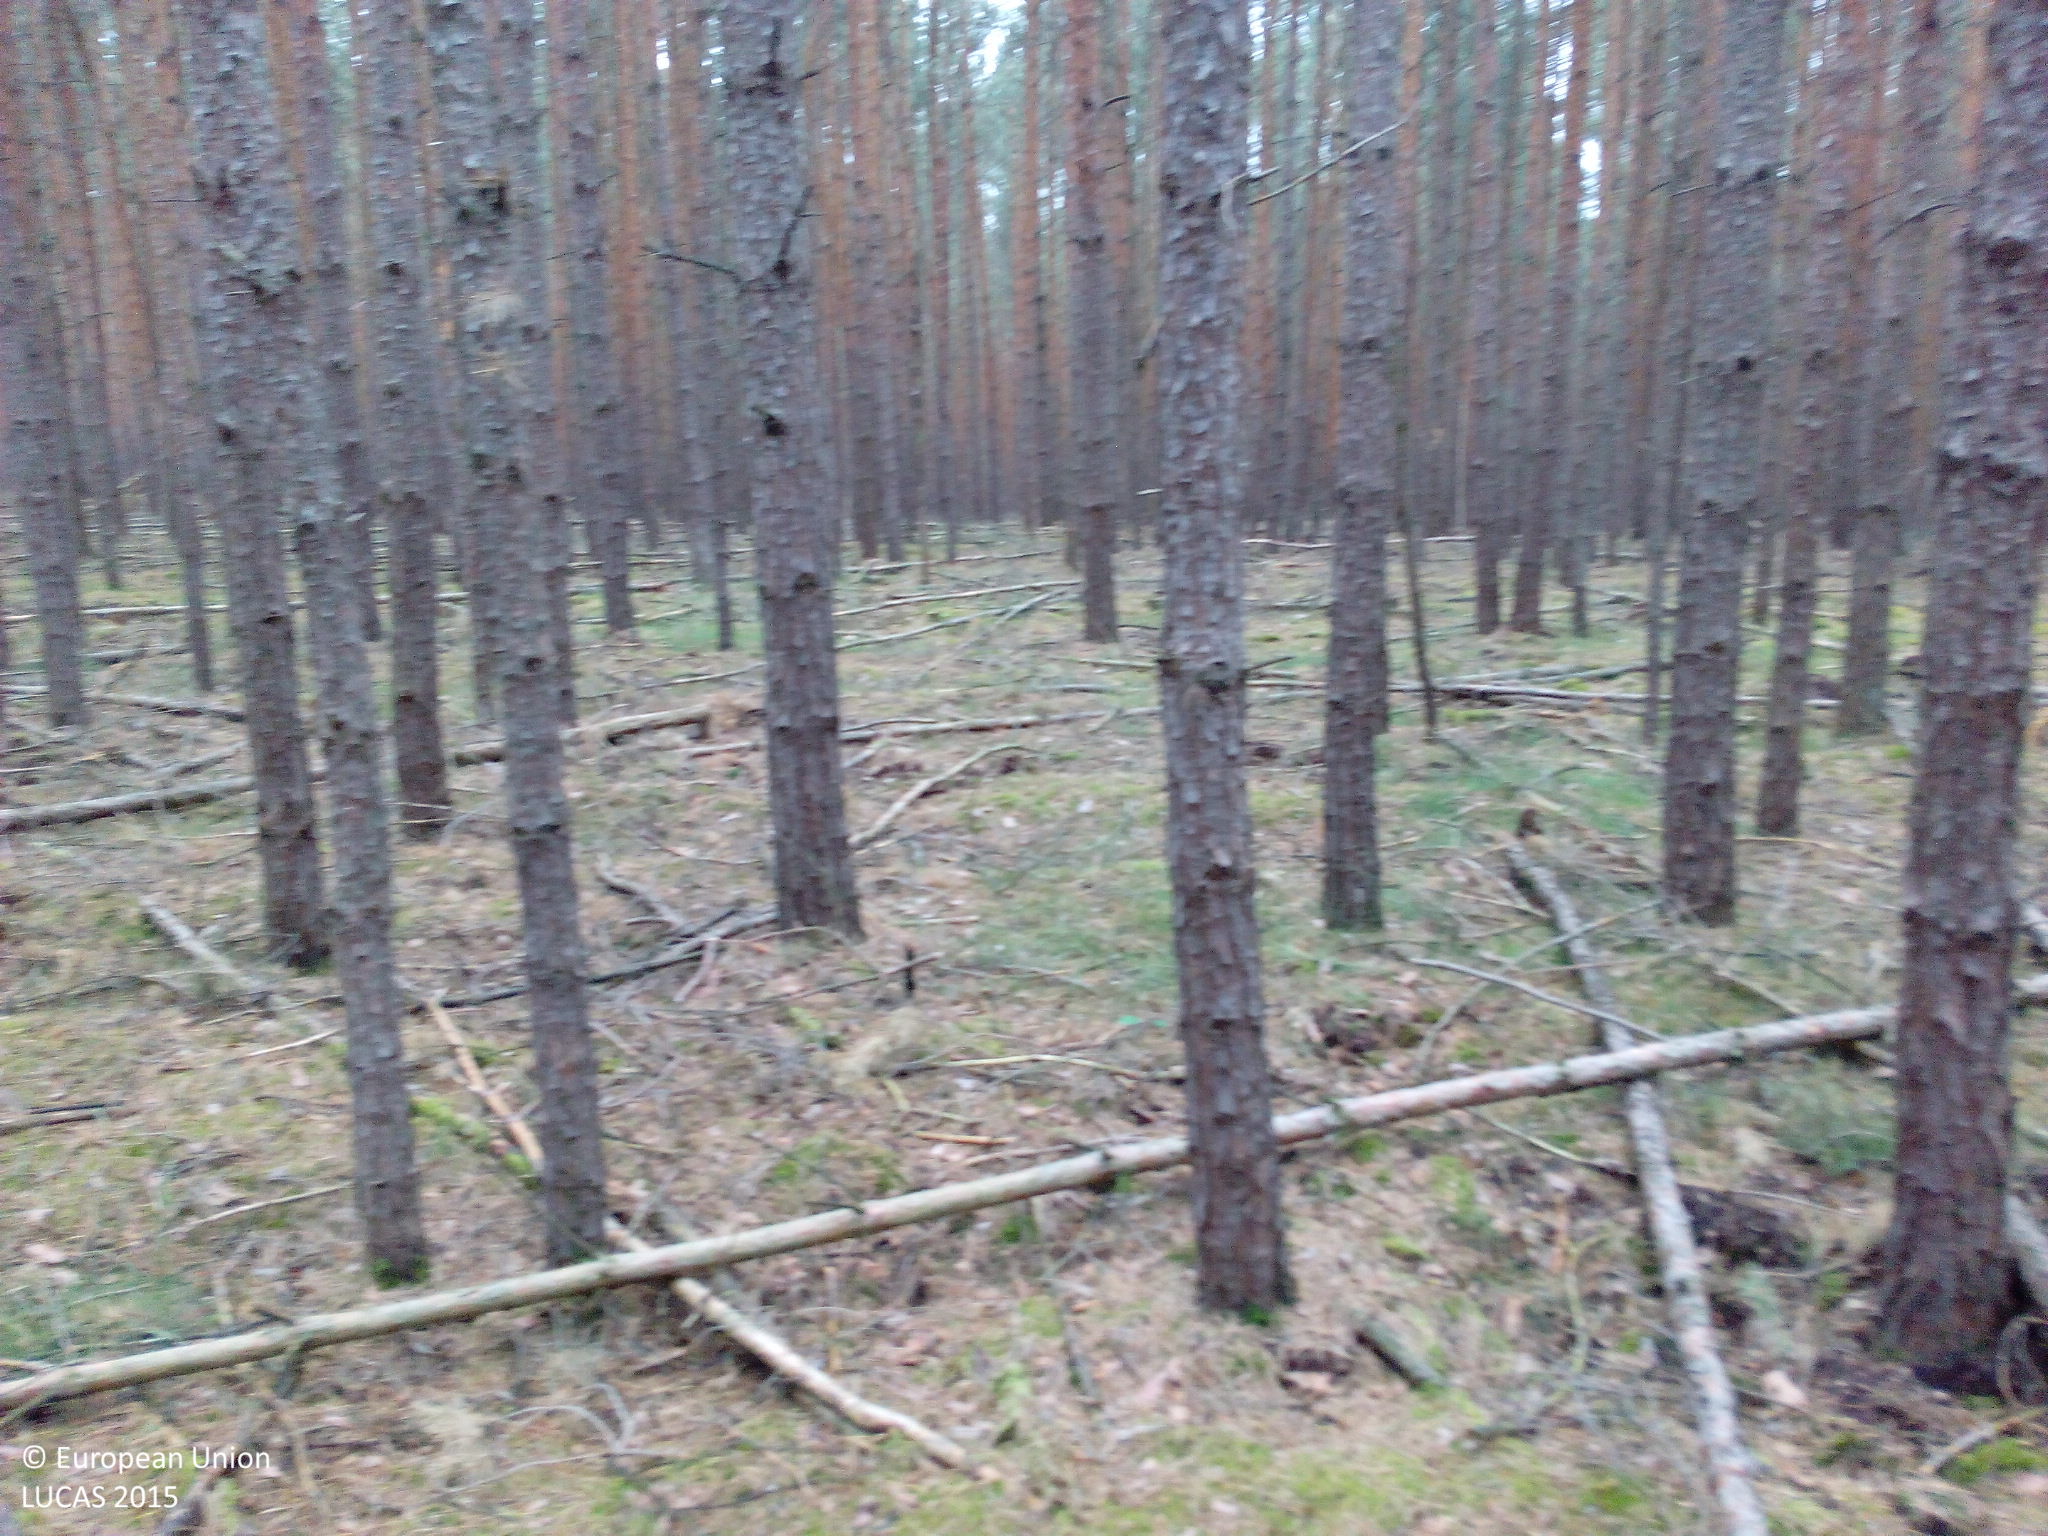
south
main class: Woodland
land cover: Pine dominated coniferous woodland
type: hemiboreal forest and nemoral coniferous forest and mixed broadleaved-coniferous forest
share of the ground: > 75 %
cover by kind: coniferous forest trees 90 %, lichens and mosses 10 %
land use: Forestry
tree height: > 5 m
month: June
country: DE
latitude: 52.2240
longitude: 12.5615
